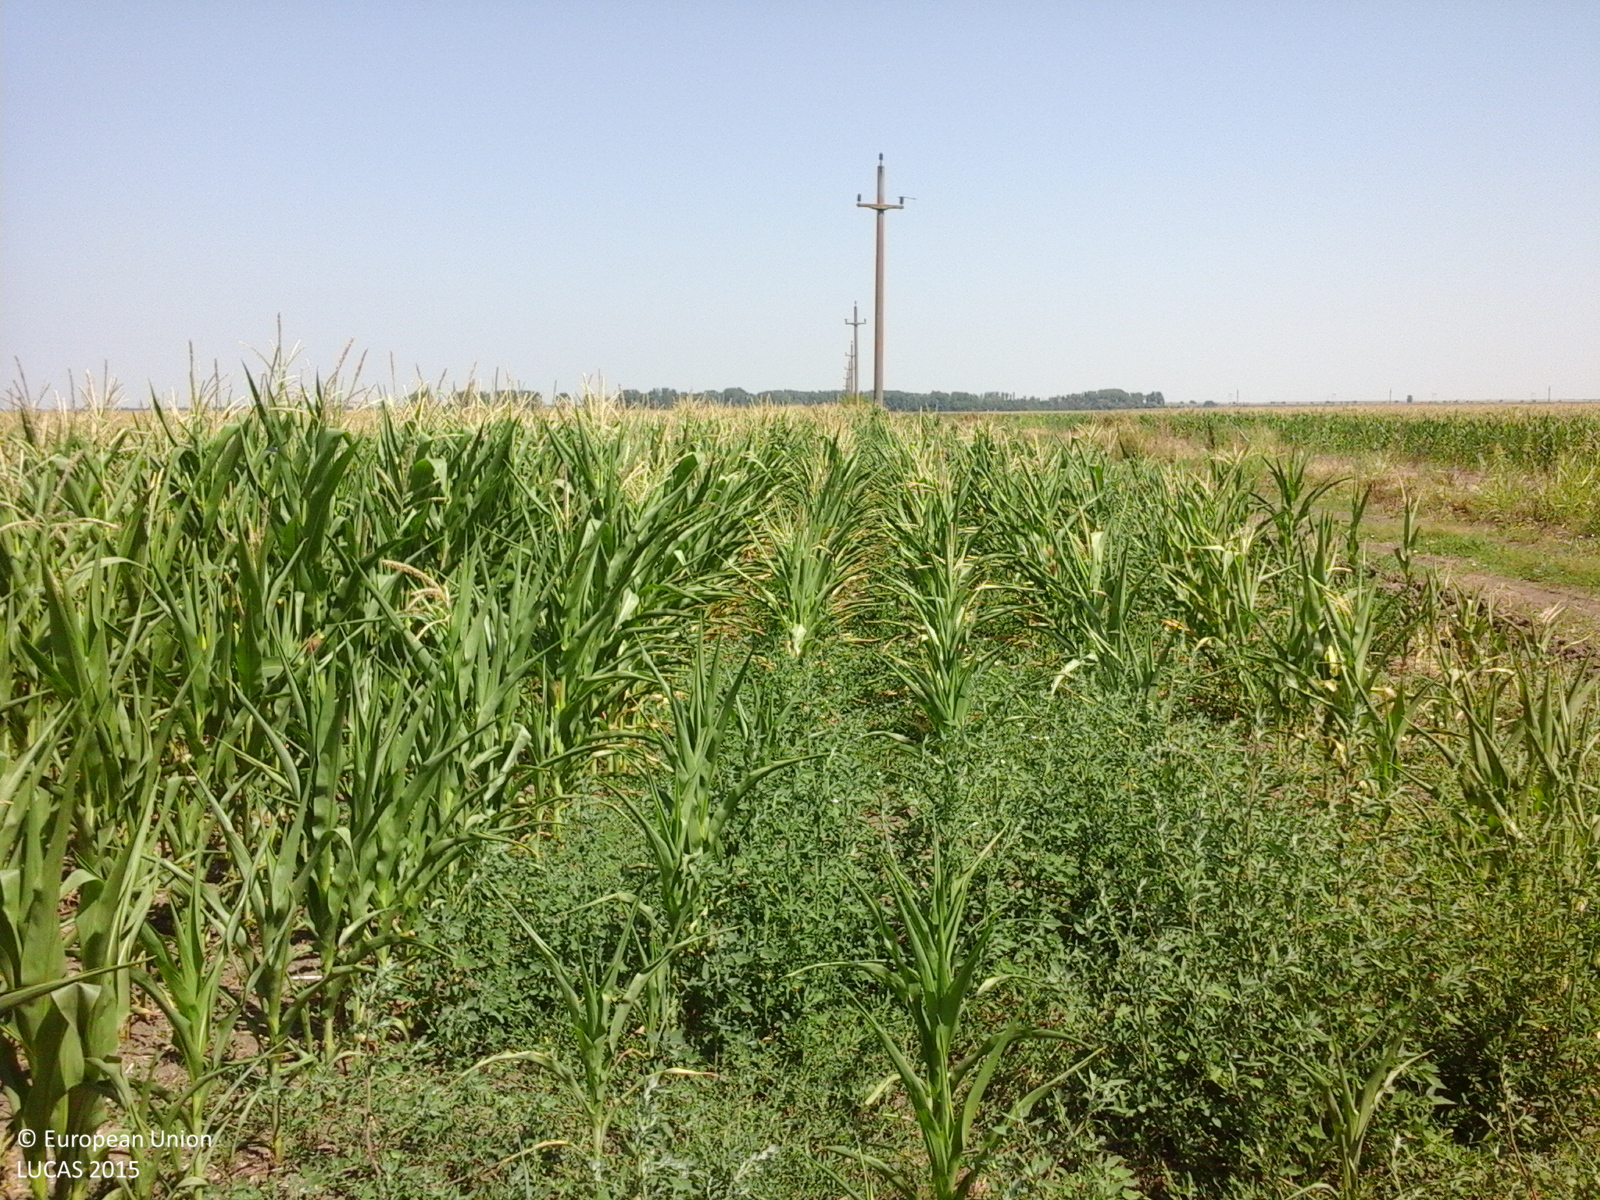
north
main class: Cropland
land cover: Maize
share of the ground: > 75 %
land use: Agriculture (excluding fallow land and kitchen gardens)
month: July
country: RO
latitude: 44.1687
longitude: 26.9962
